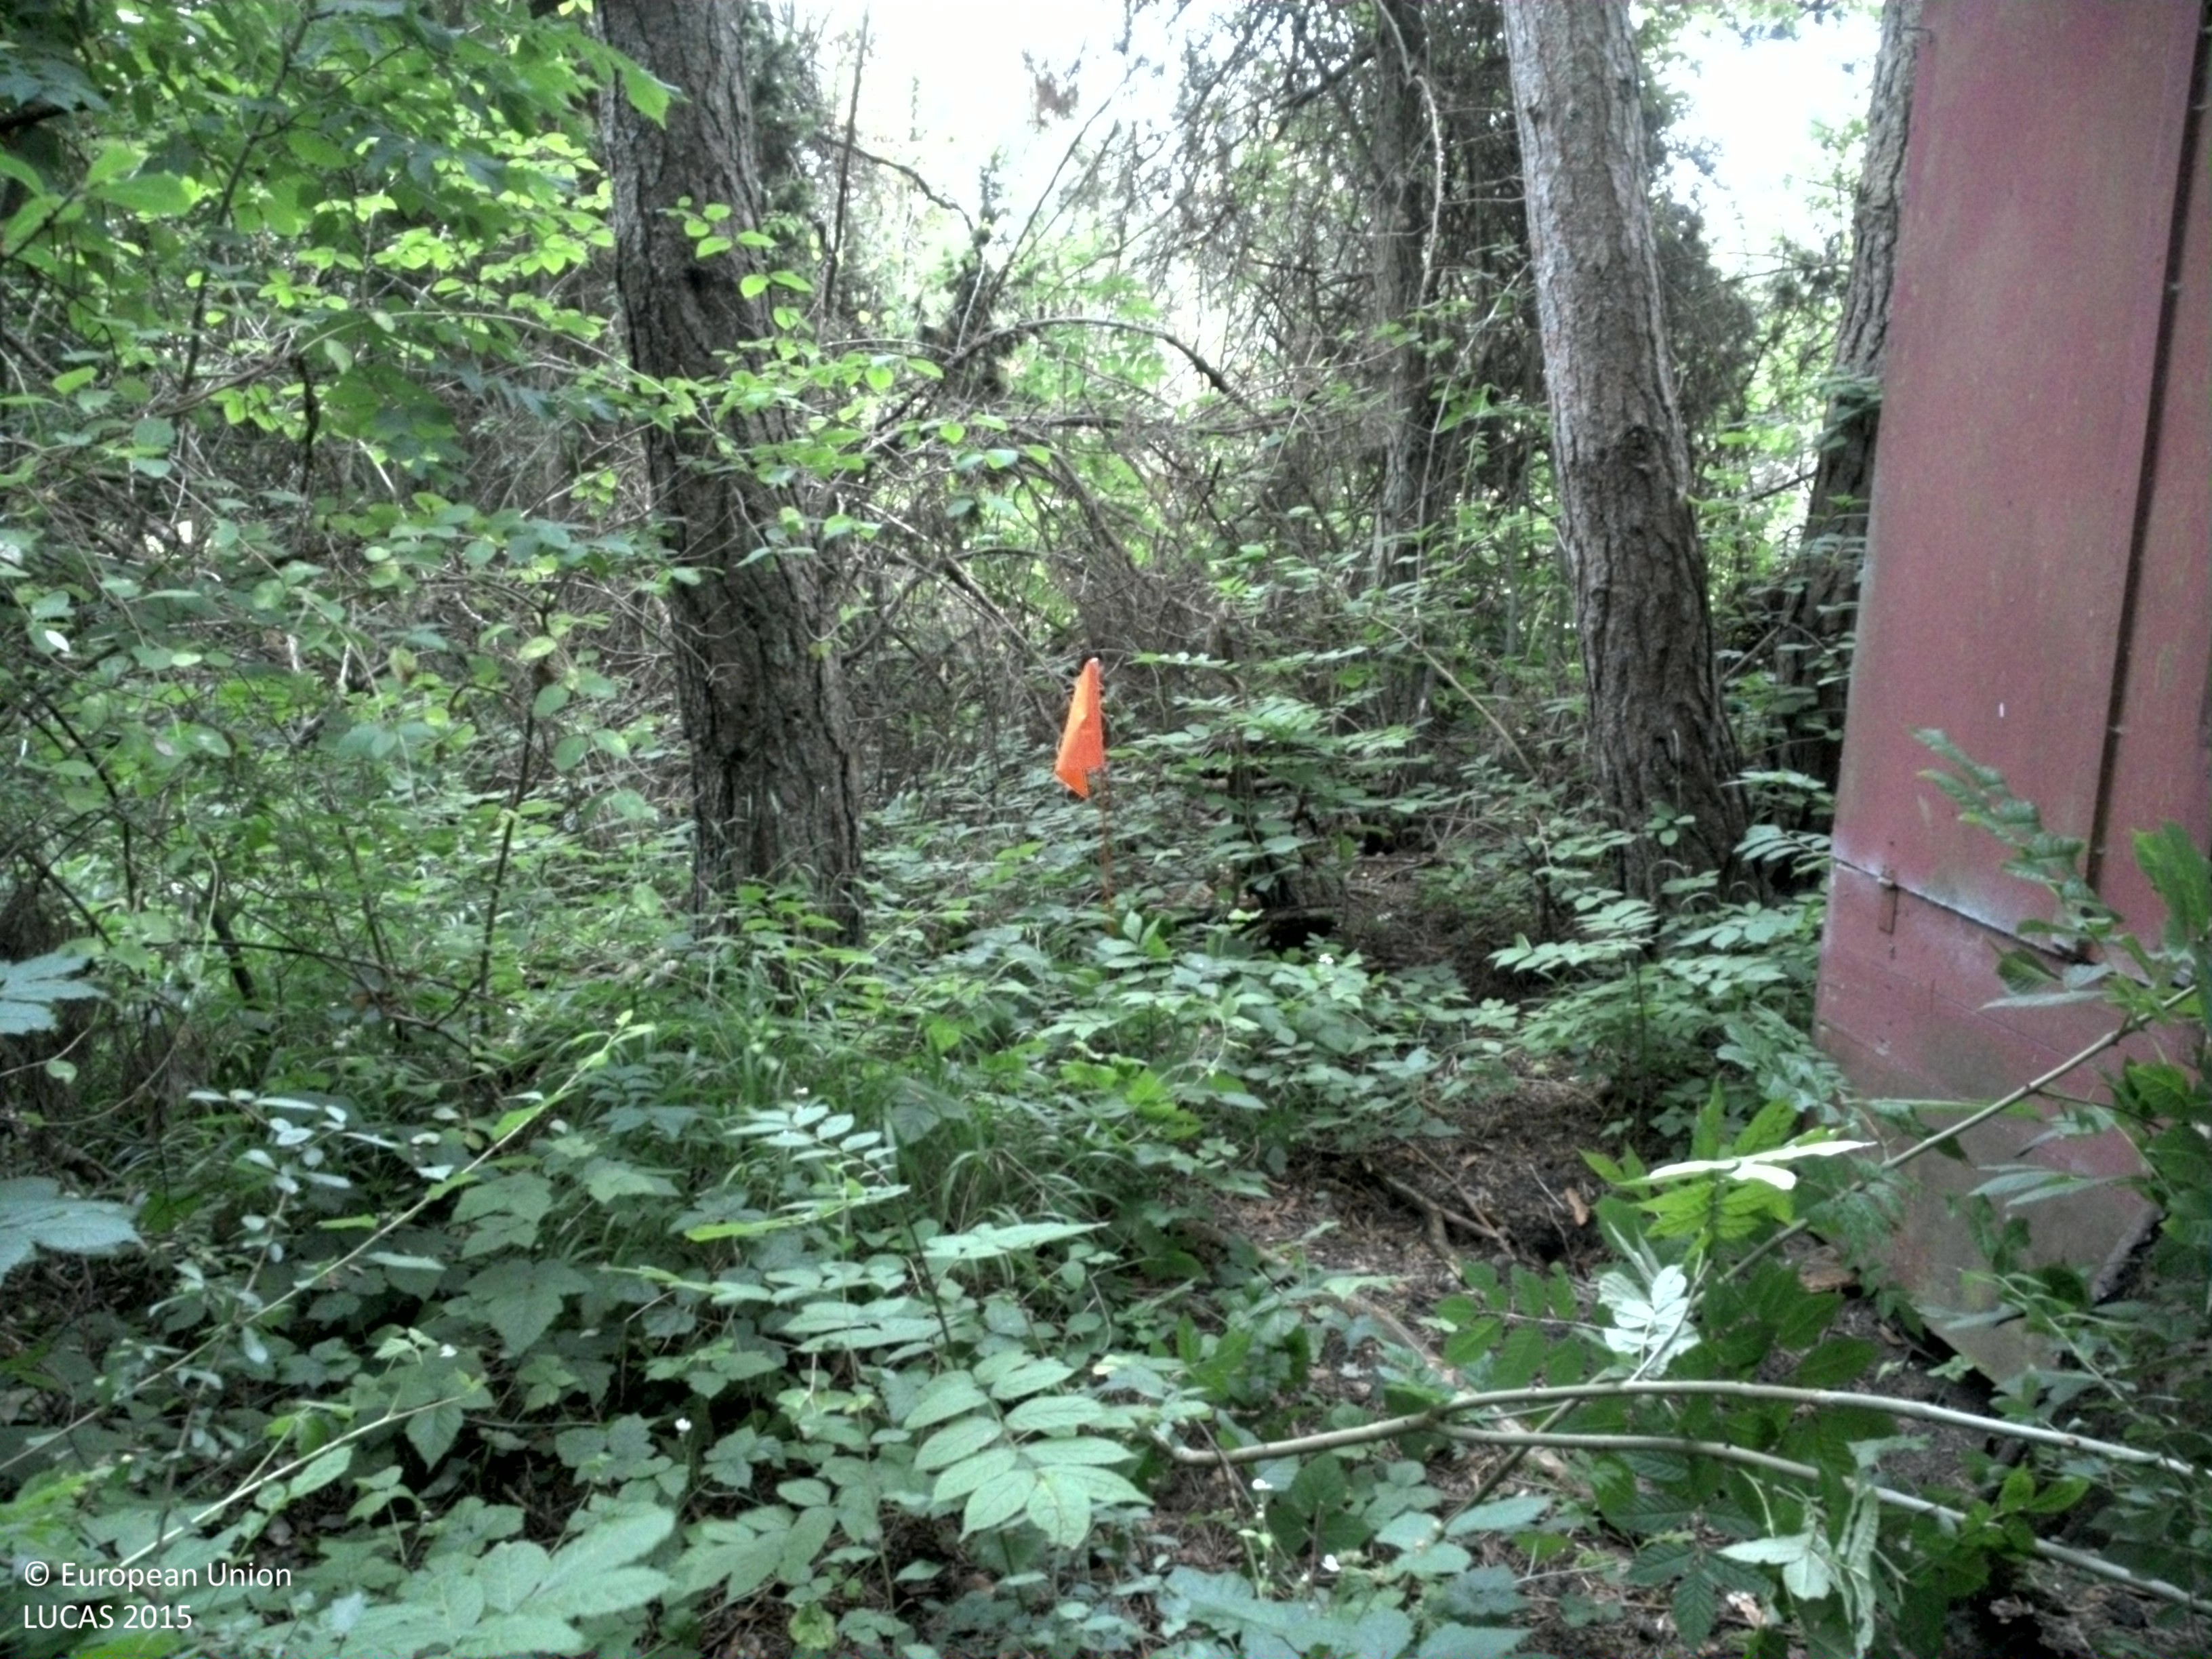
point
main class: Woodland
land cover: Pine dominated coniferous woodland
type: hemiboreal forest and nemoral coniferous forest and mixed broadleaved-coniferous forest
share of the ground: > 75 %
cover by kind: coniferous forest trees 75 %, shrubs 15 %, broadleaved forest trees 5 %, herbaceous plants 5 %
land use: Forestry
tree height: > 5 m
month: July
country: SE
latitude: 57.2214
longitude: 18.5723
